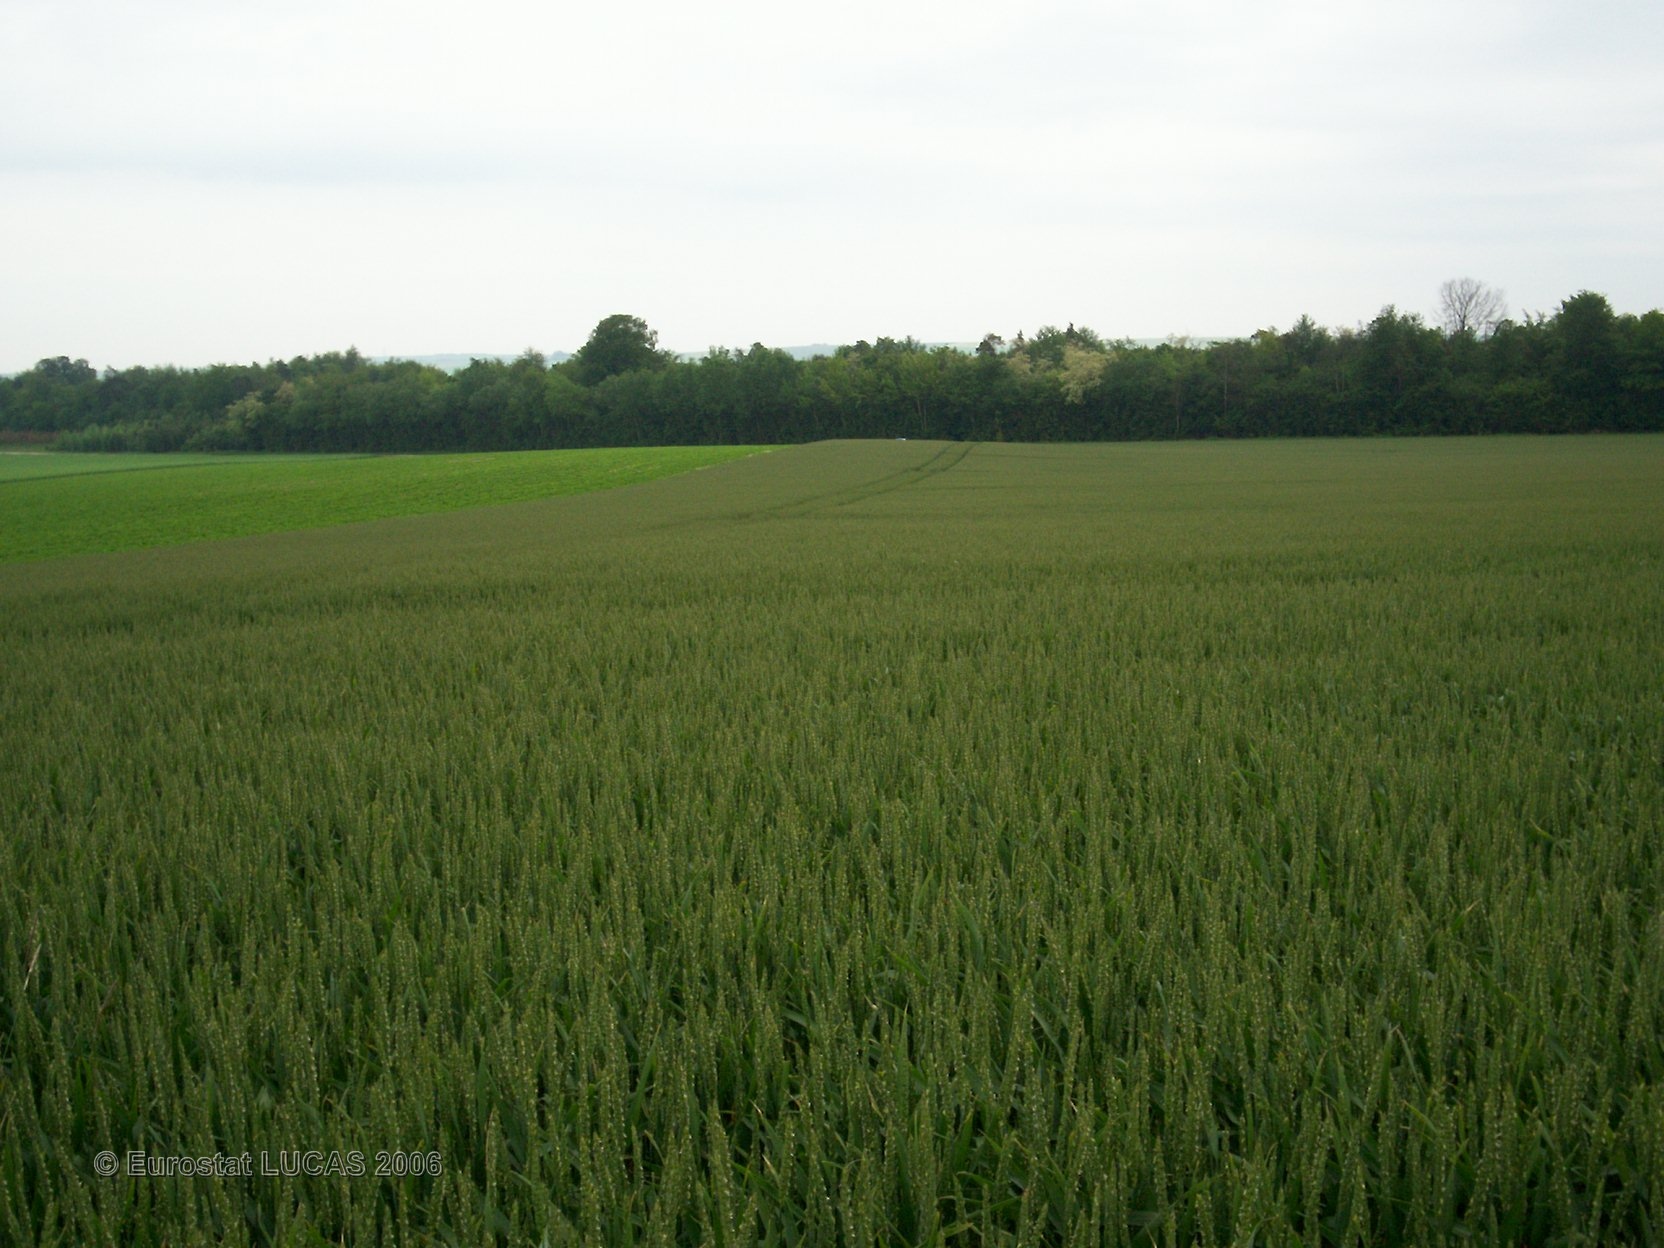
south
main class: Cropland
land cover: Common wheat
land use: Agriculture (excluding fallow land and kitchen gardens)
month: June
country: FR
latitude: 48.7516
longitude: 4.4611
